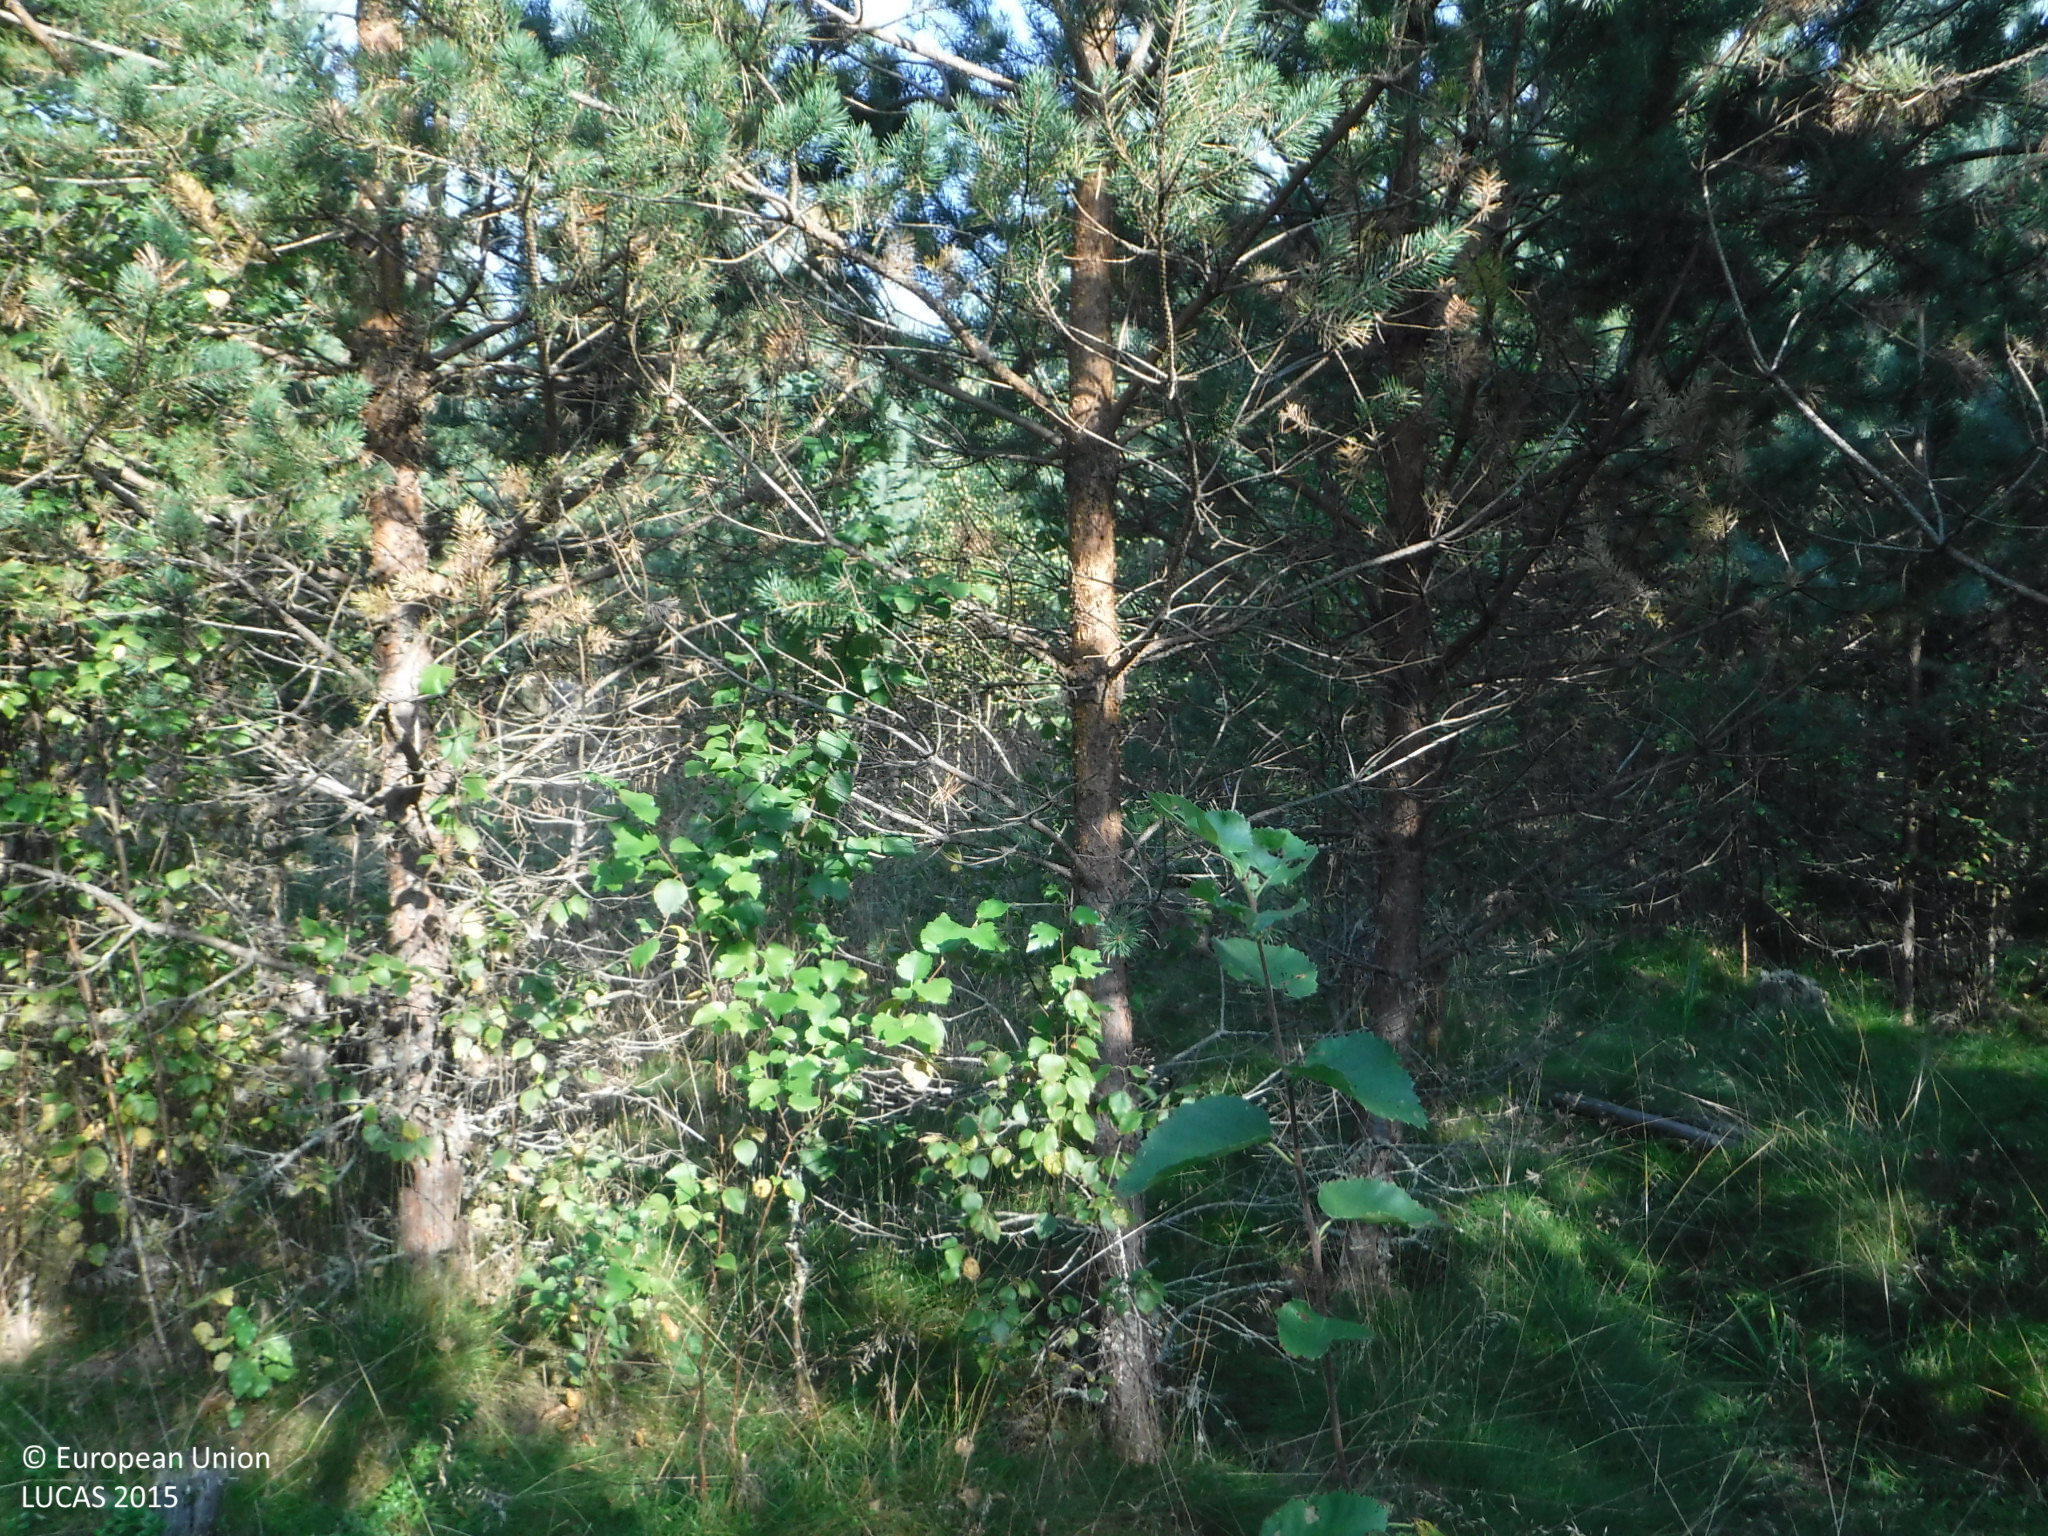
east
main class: Woodland
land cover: Pine dominated coniferous woodland
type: boreal forest
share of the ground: 25 - 50 %
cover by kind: herbaceous plants 50 %, coniferous forest trees 30 %, shrubs 10 %, broadleaved forest trees 5 %, lichens and mosses 5 %
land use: Forestry
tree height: > 5 m
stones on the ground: < 10 %
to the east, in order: Pine dominated coniferous woodland; Pine dominated mixed woodland; Spruce dominated coniferous woodland; Ditches and canals; Spruce dominated coniferous woodland; Pine dominated mixed woodland; Ditches and canals; Pine dominated coniferous woodland; Ditches and canals; Pine dominated coniferous woodland
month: August
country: FI
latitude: 61.2559
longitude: 23.0287
